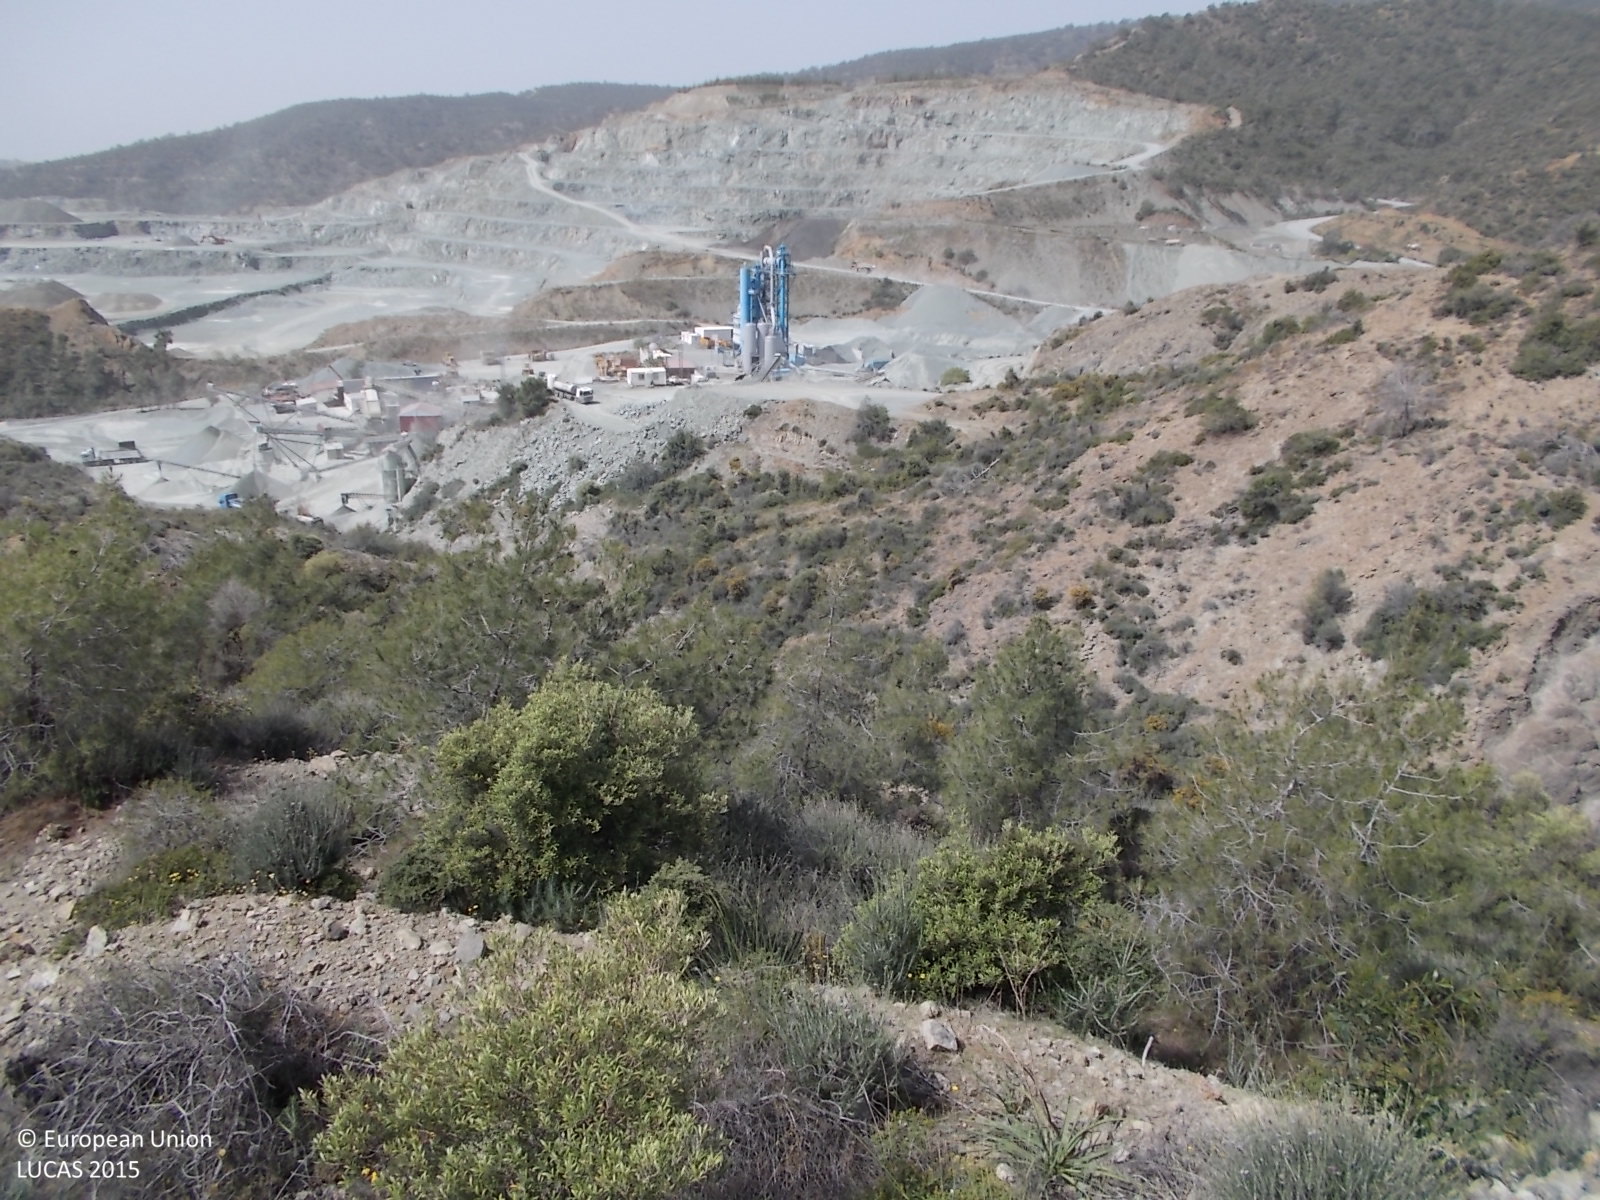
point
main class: Shrubland
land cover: Shrubland with sparse tree cover
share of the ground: > 75 %
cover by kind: shrubs 95 %, coniferous forest trees 5 %
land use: Semi-natural and natural areas not in use
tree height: > 5 m
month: April
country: CY
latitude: 34.7912
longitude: 33.1568
